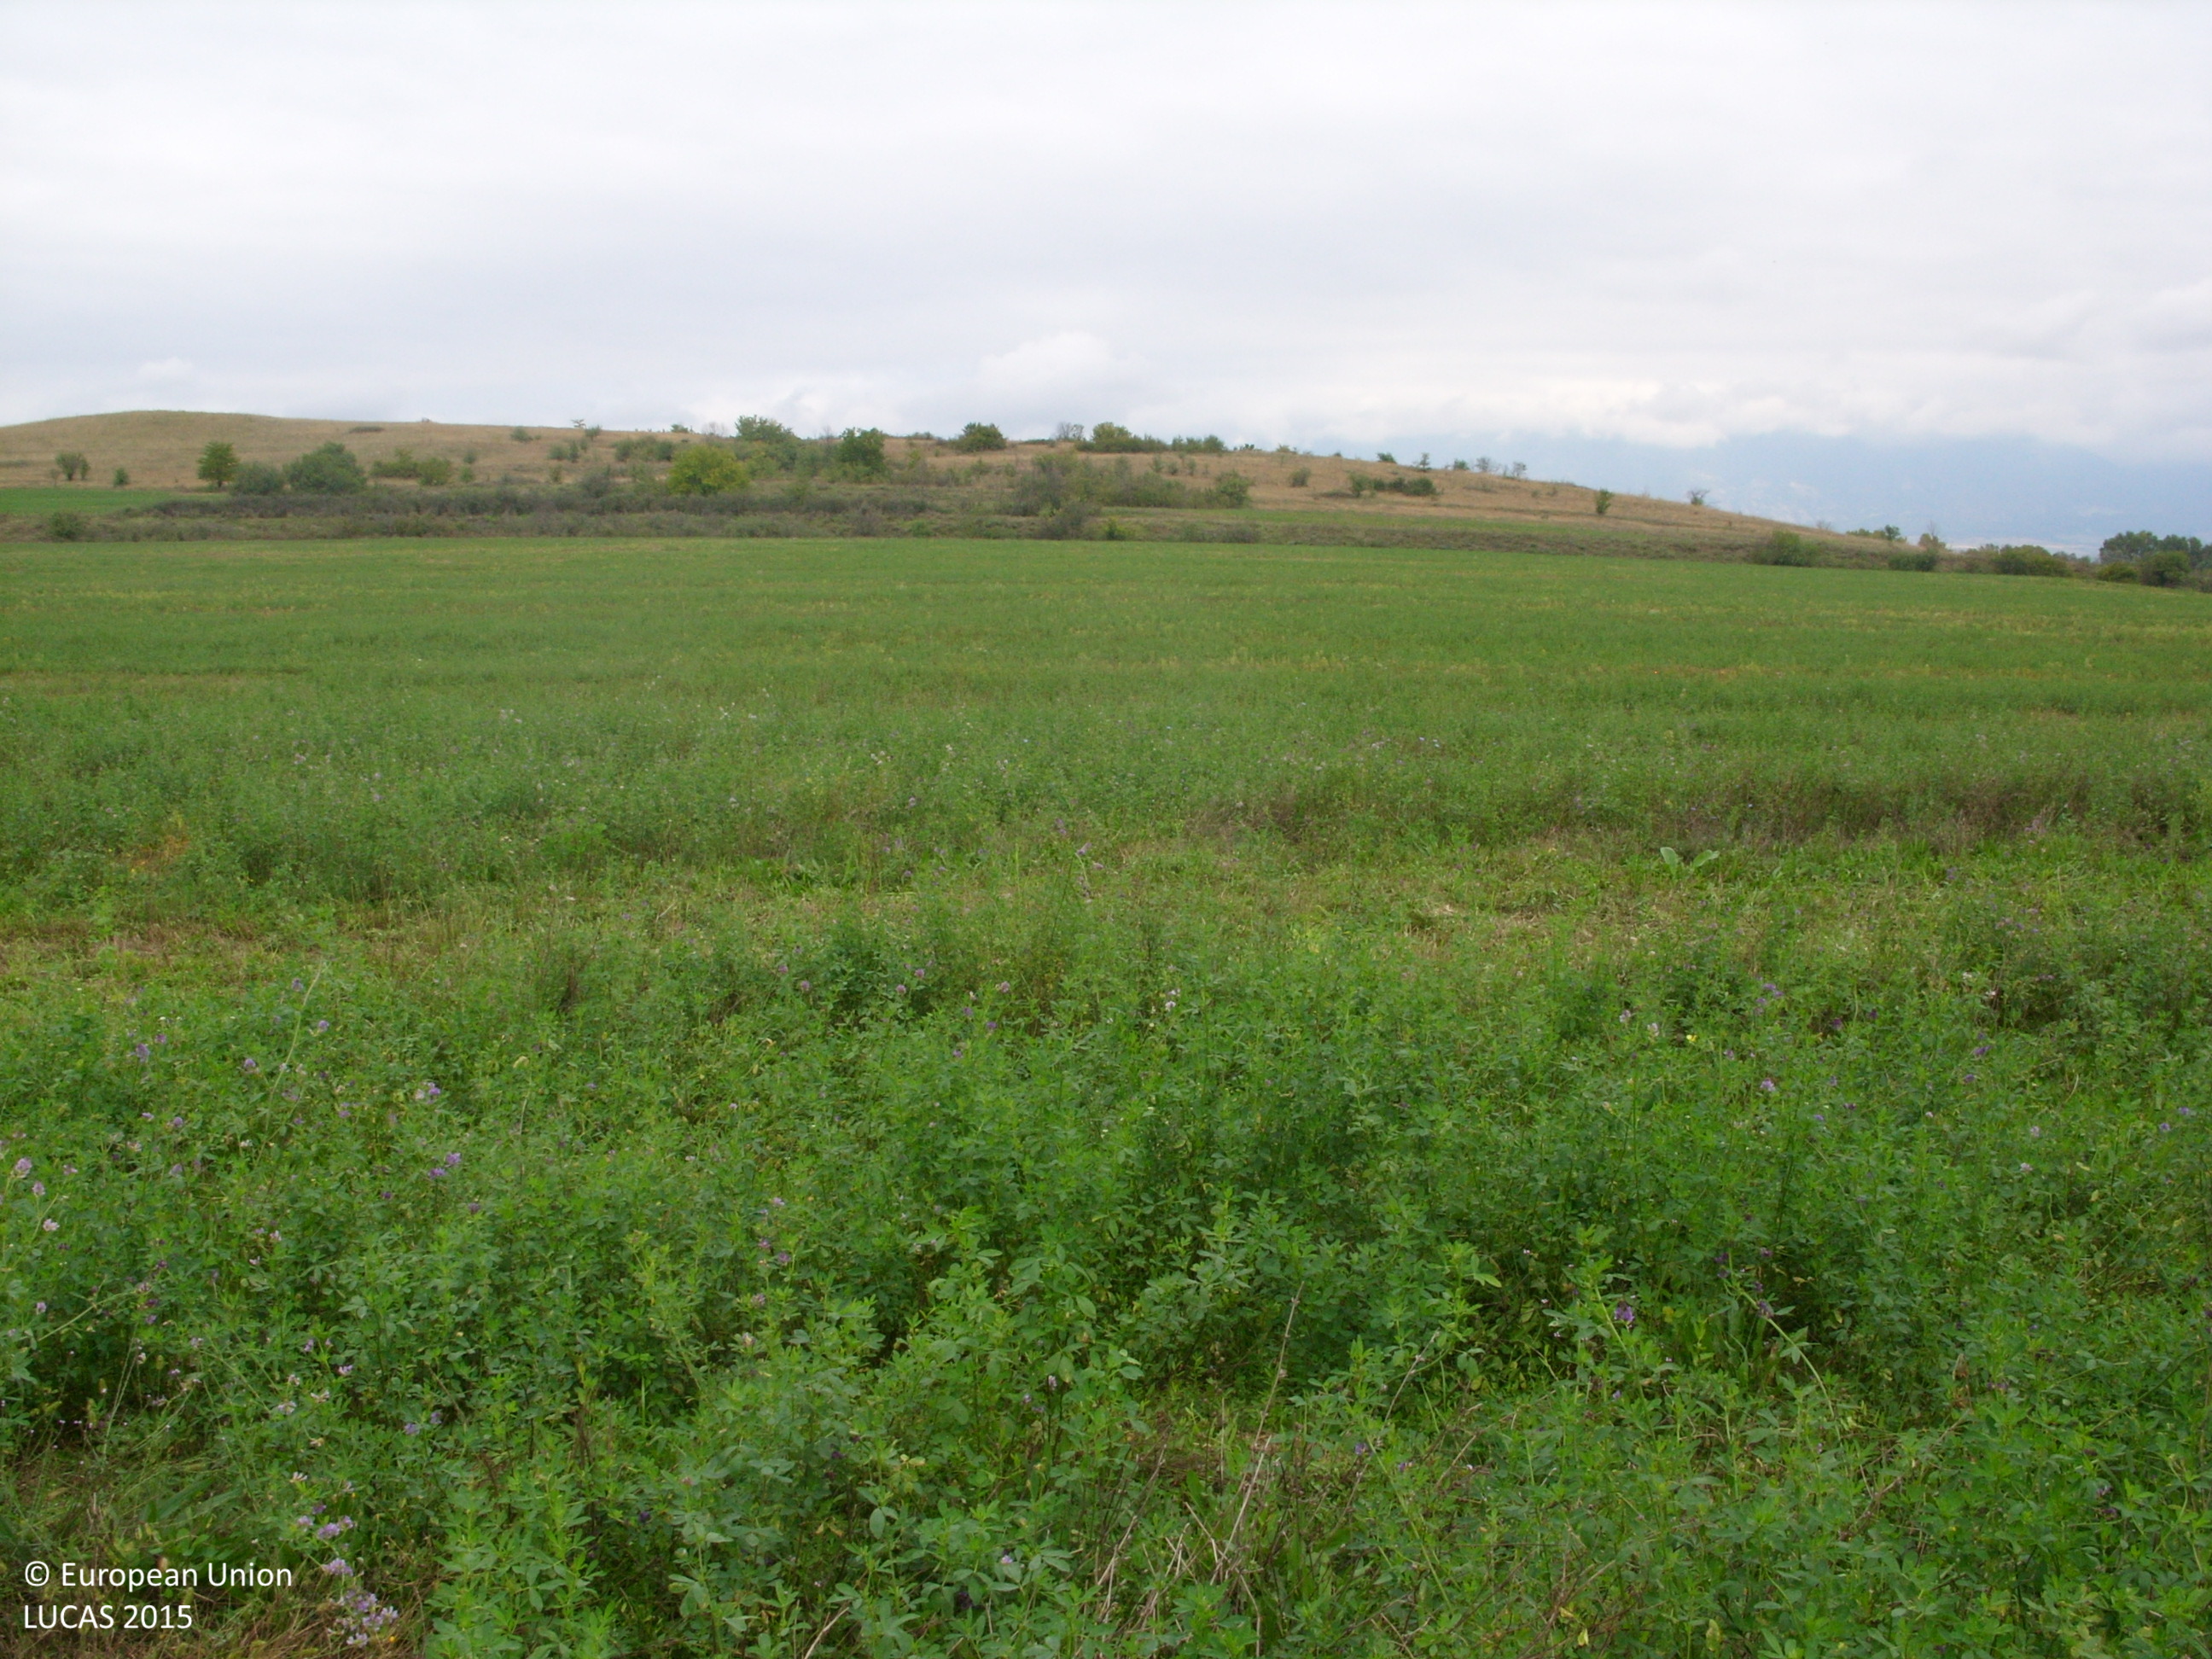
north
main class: Cropland
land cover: Lucerne
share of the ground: > 75 %
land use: Agriculture (excluding fallow land and kitchen gardens)
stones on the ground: < 10 %
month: October
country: BG
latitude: 42.5277
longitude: 24.8242
